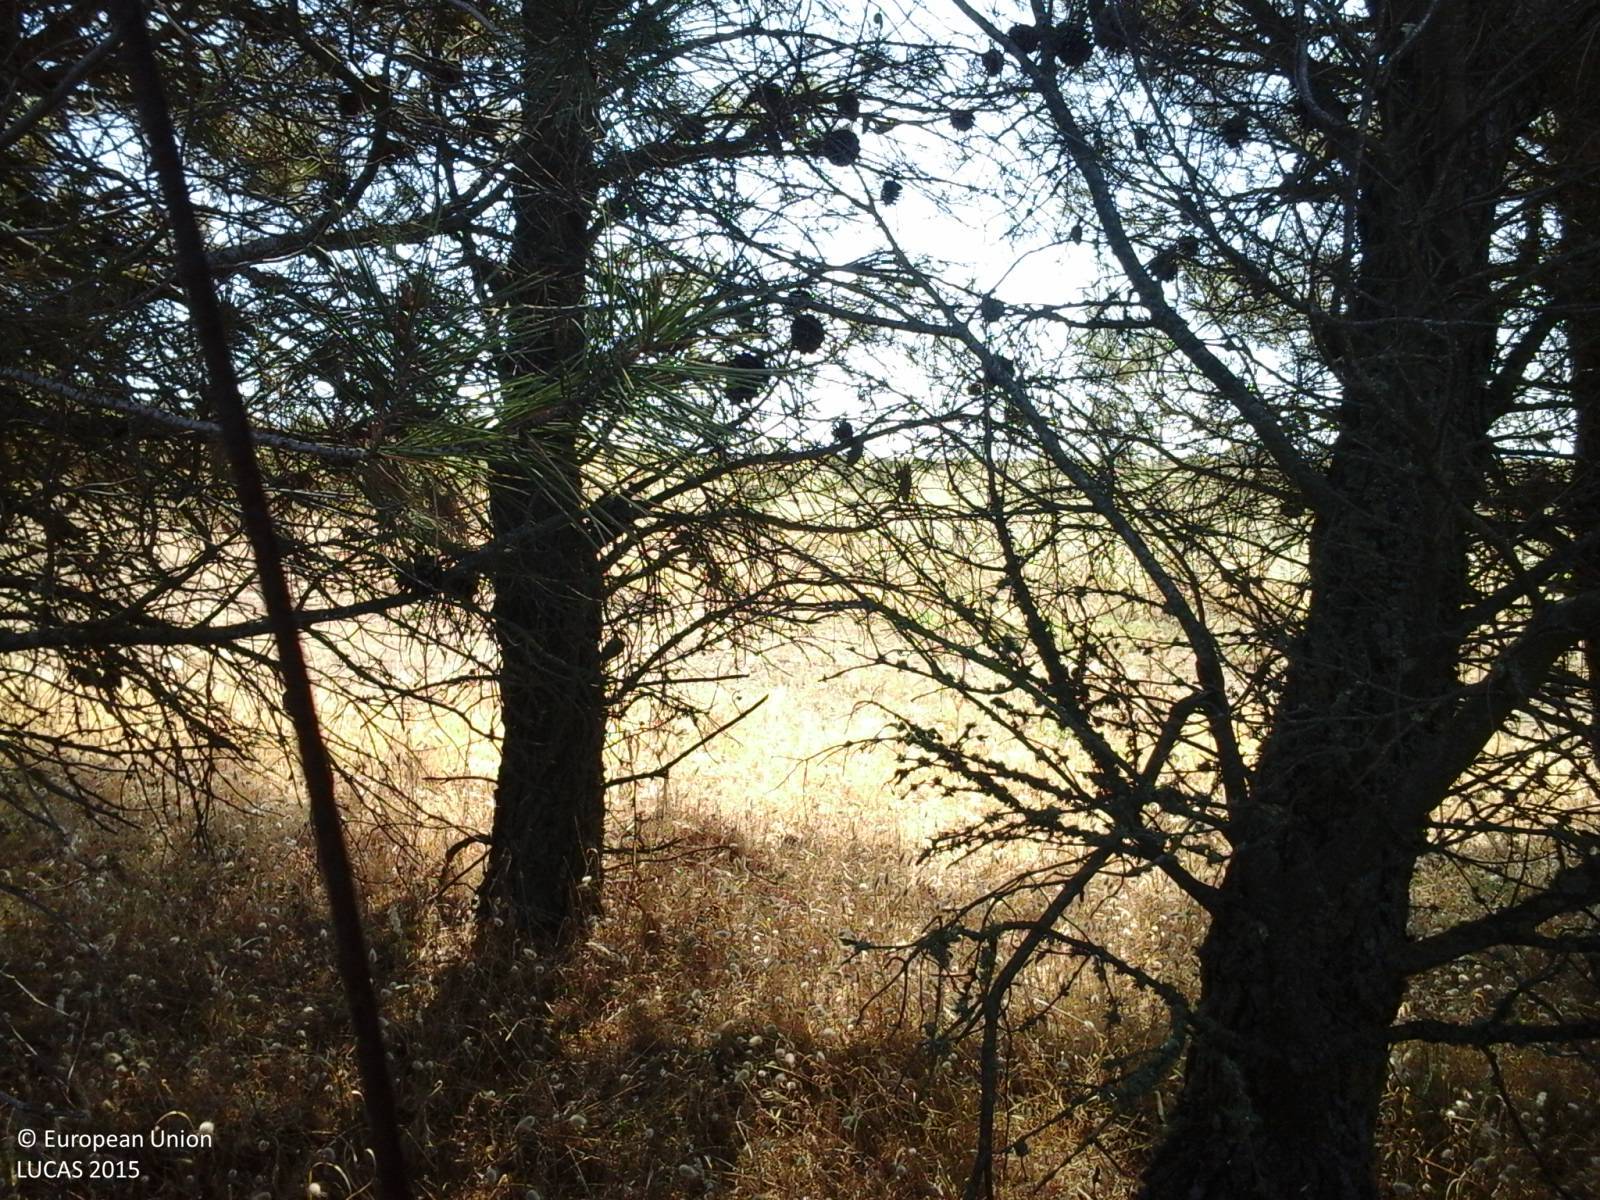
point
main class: Grassland
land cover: Grassland without tree/shrub cover
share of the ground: > 75 %
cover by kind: herbaceous plants 100 %
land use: Agriculture (excluding fallow land and kitchen gardens)
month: June
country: IT
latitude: 40.5308
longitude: 8.7431
